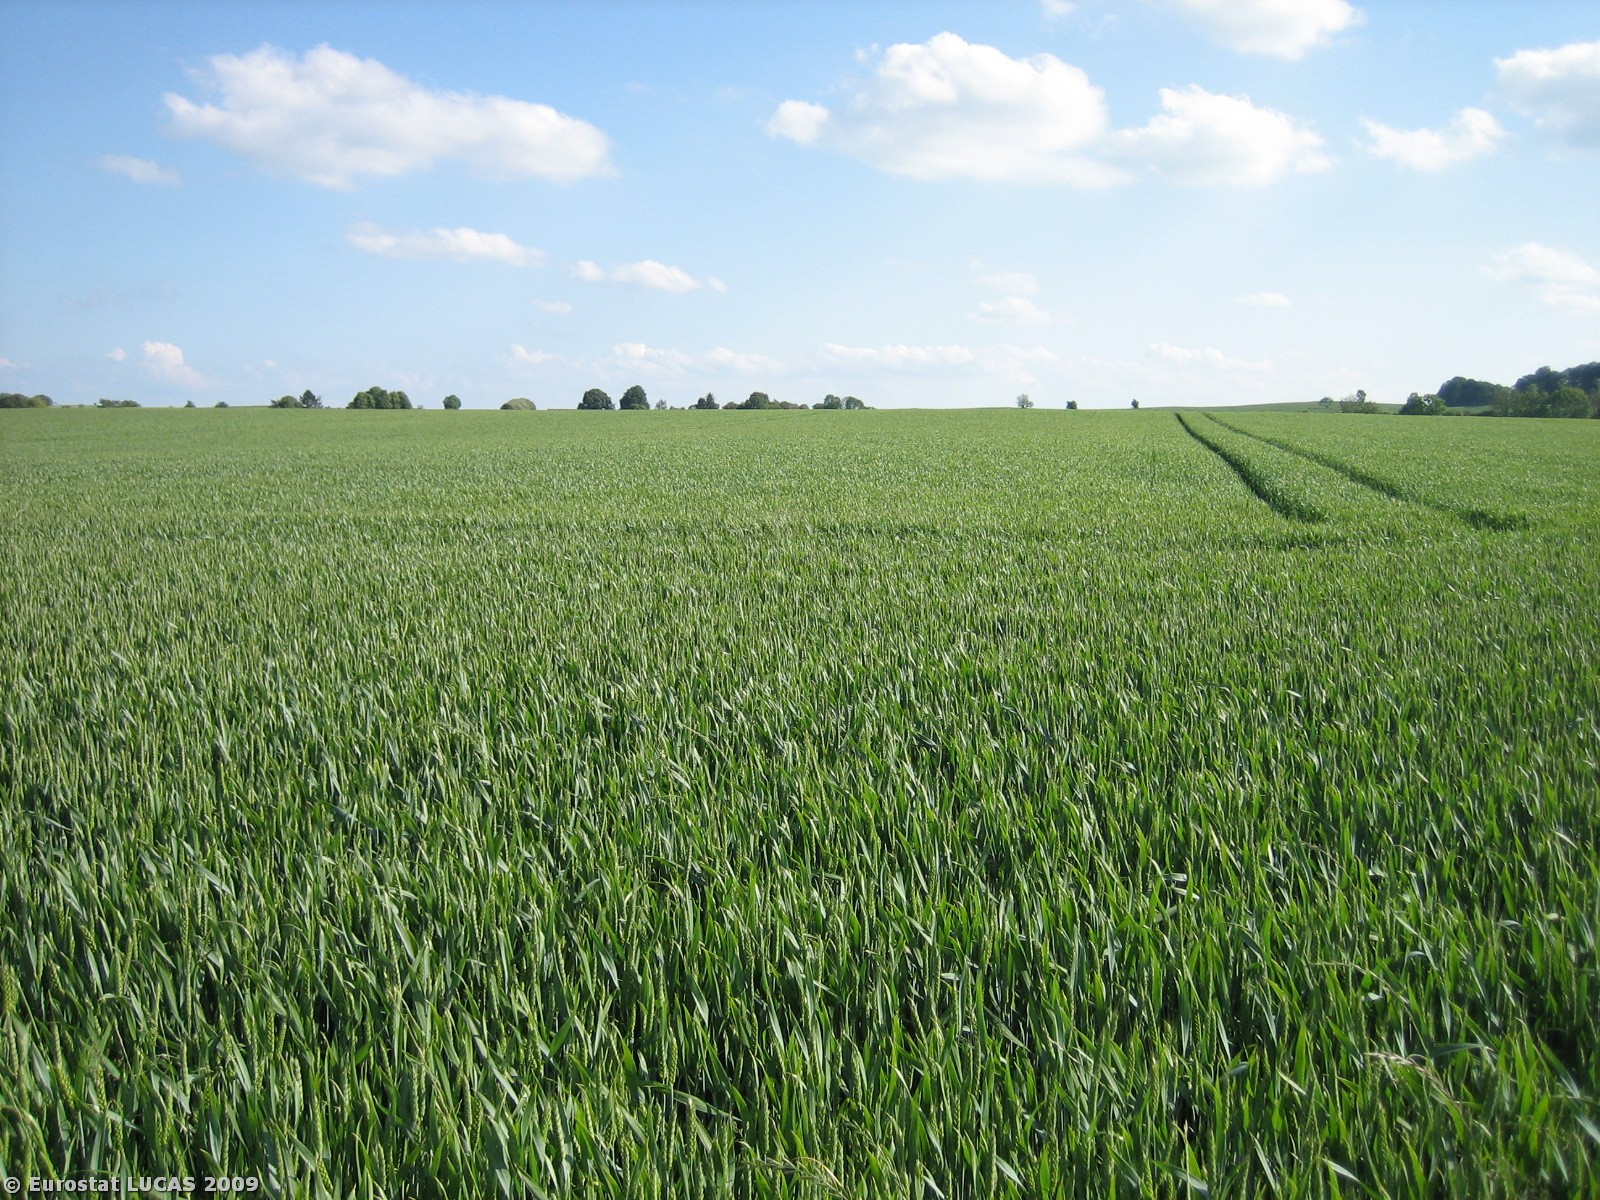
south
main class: Cropland
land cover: Common wheat
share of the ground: > 75 %
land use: Agriculture (excluding fallow land and kitchen gardens)
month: June
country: DK
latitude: 55.8102
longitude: 9.9203
